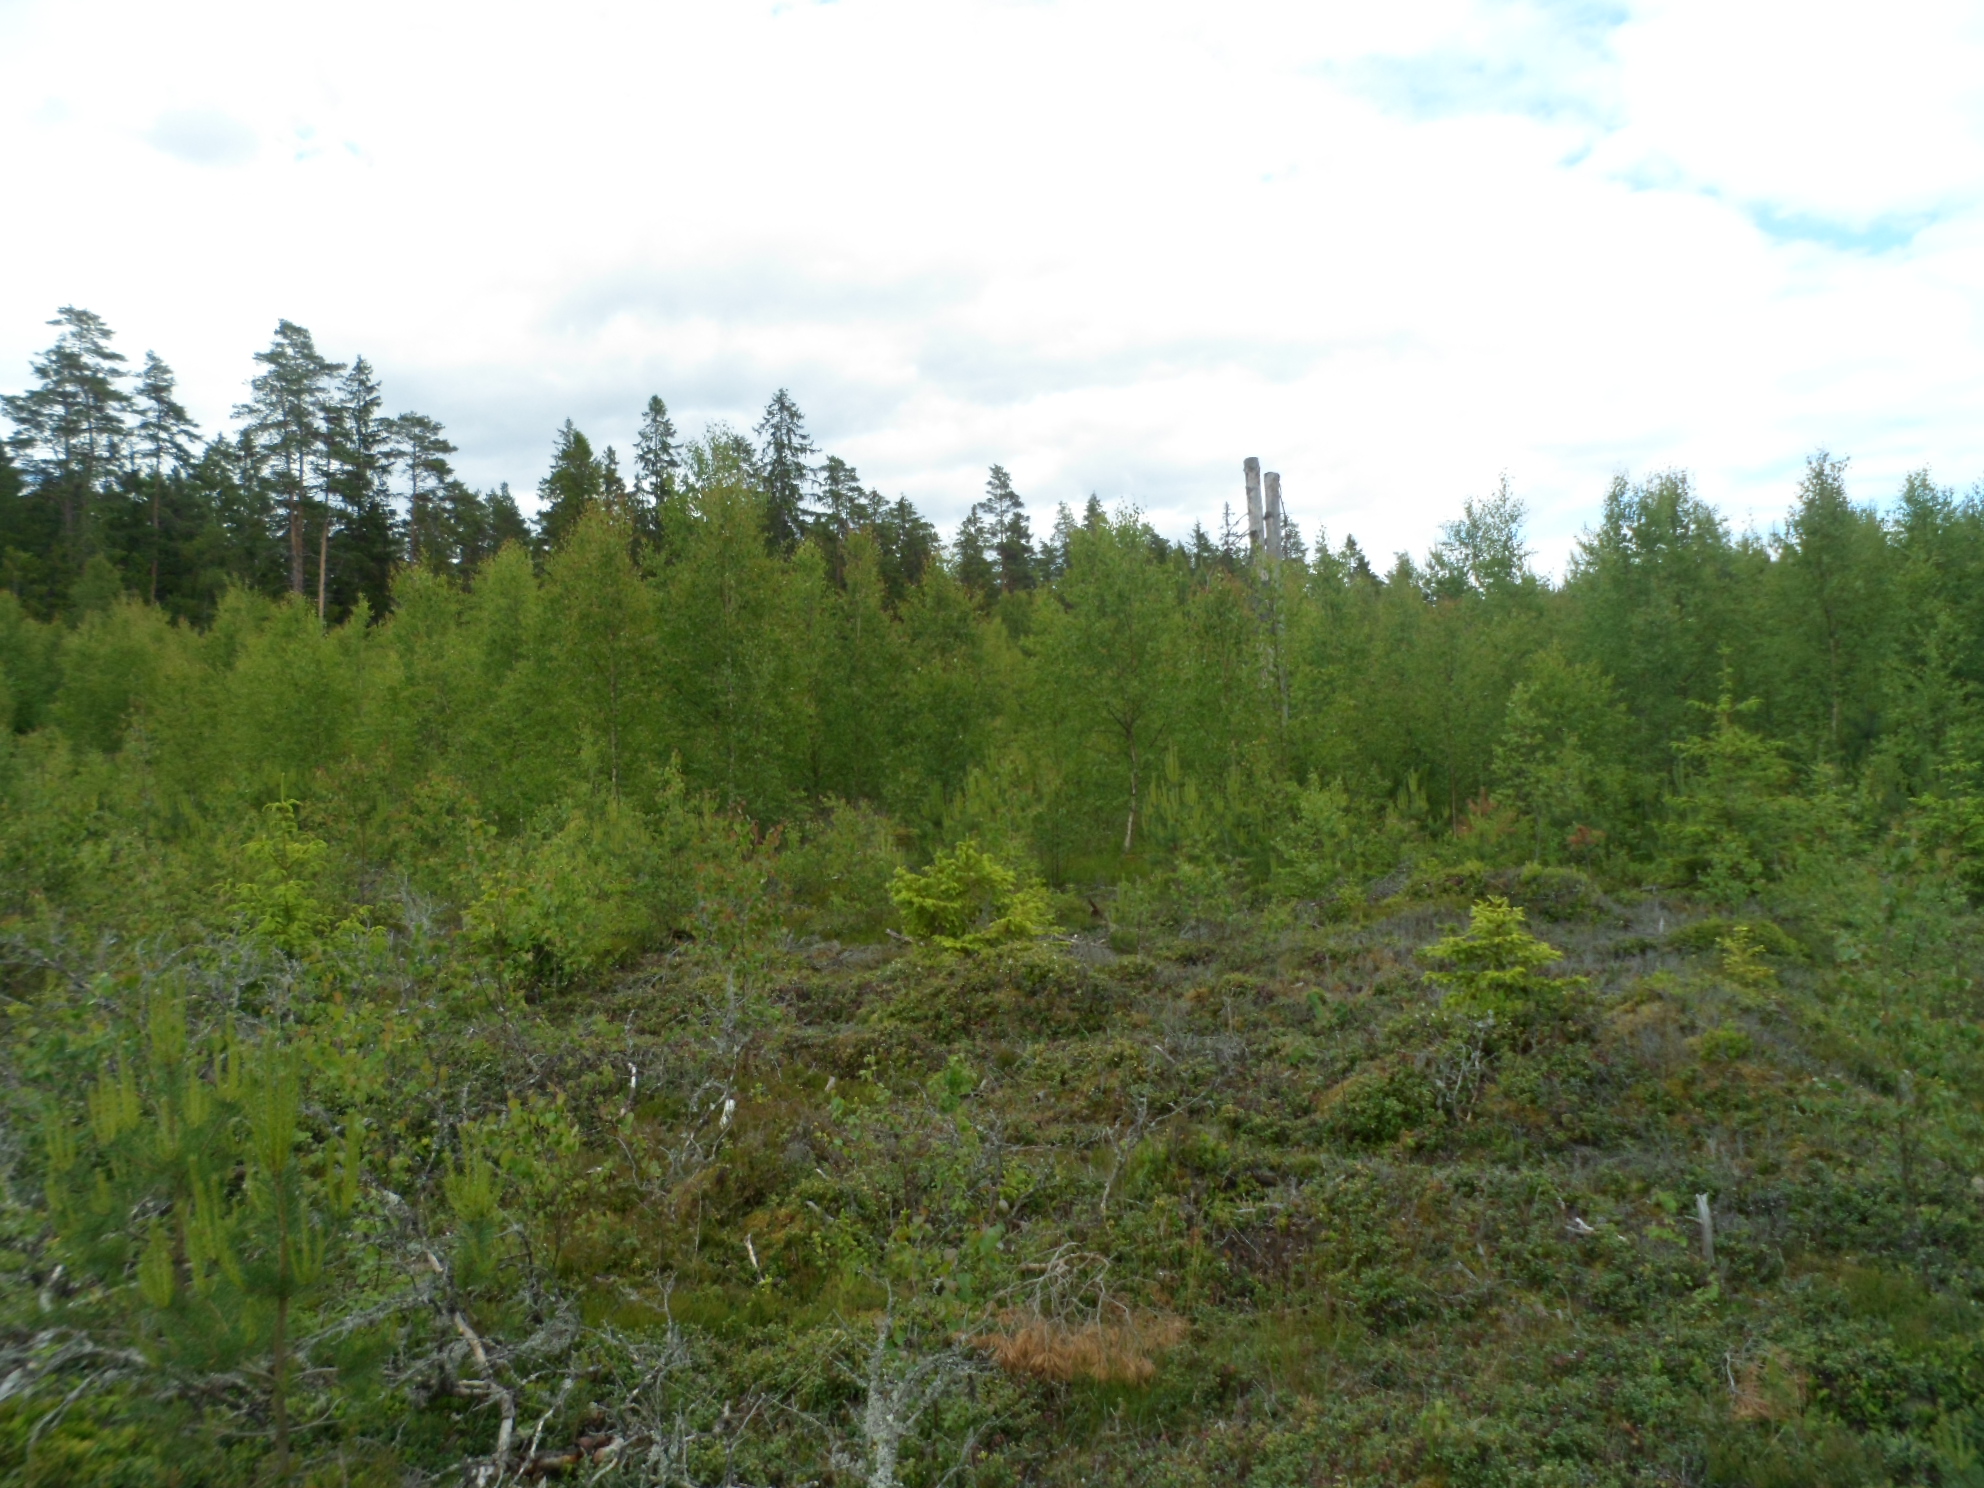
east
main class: Woodland
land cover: Pine dominated mixed woodland
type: boreal forest
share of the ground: 25 - 50 %
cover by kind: shrubs 40 %, coniferous forest trees 20 %, broadleaved forest trees 20 %, herbaceous plants 10 %, lichens and mosses 10 %
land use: Forestry
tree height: < 5 m
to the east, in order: Pine dominated mixed woodland; Tracks; Pine dominated mixed woodland; Paved roads, cycling and walking lanes; Pine dominated coniferous woodland; Tracks; Pine dominated coniferous woodland
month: June
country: SE
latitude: 57.1038
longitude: 14.3711
